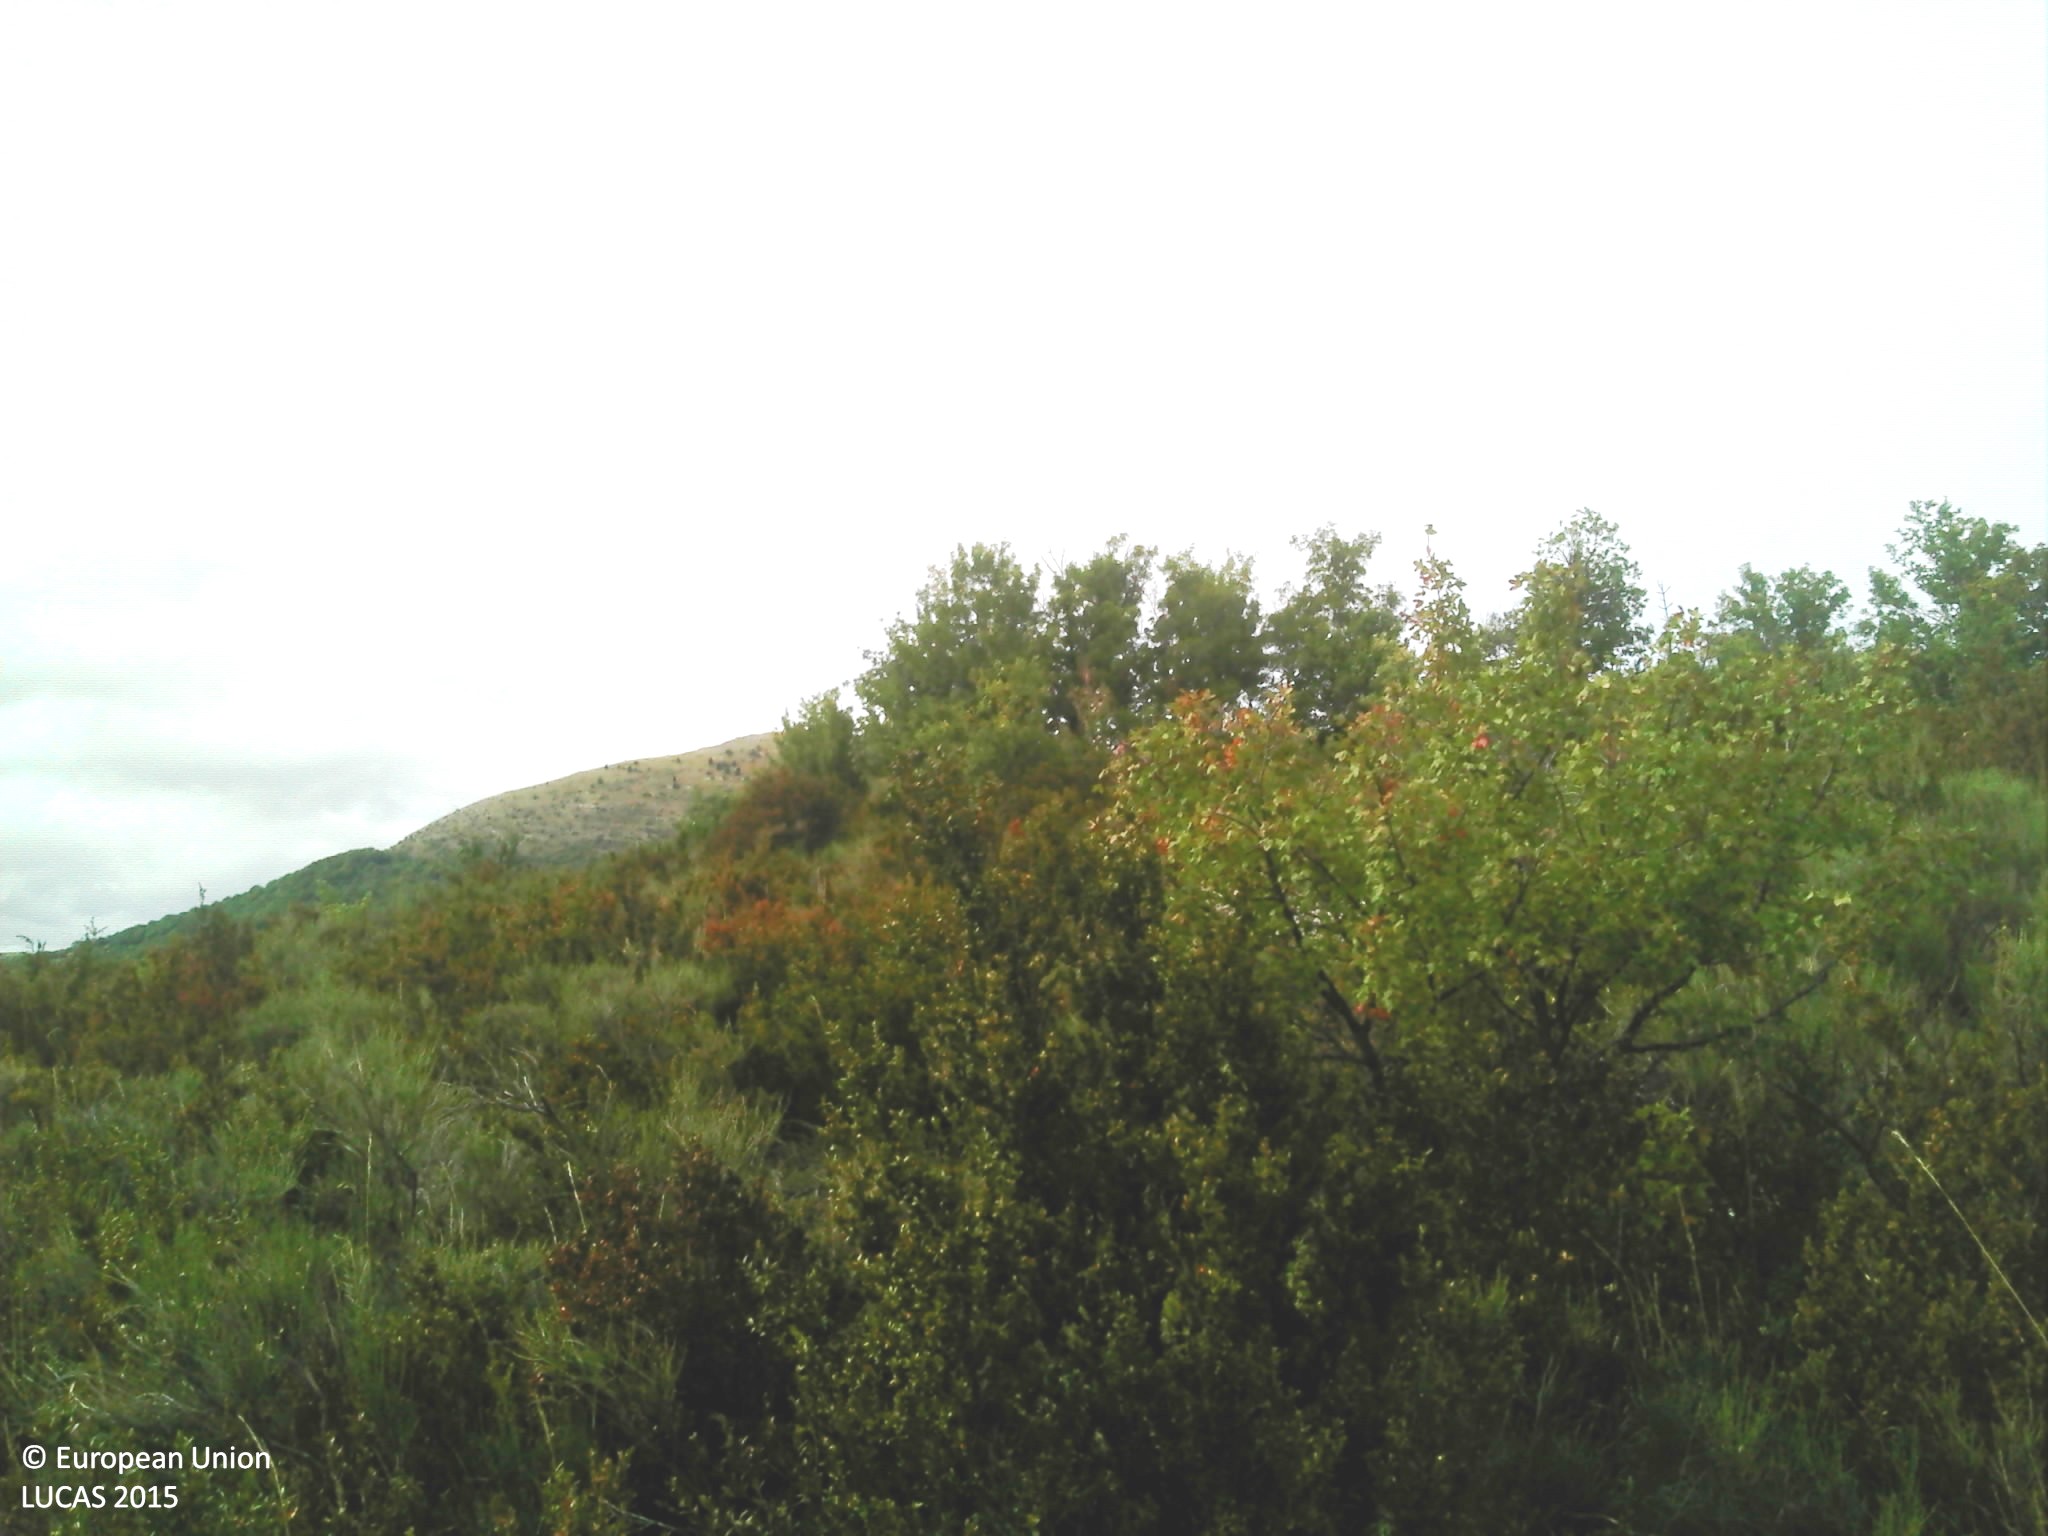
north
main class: Shrubland
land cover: Shrubland without tree cover
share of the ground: > 75 %
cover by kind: shrubs 95 %, consolidated bare surface 5 %
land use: Semi-natural and natural areas not in use
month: September
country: FR
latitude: 44.5719
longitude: 5.3602
